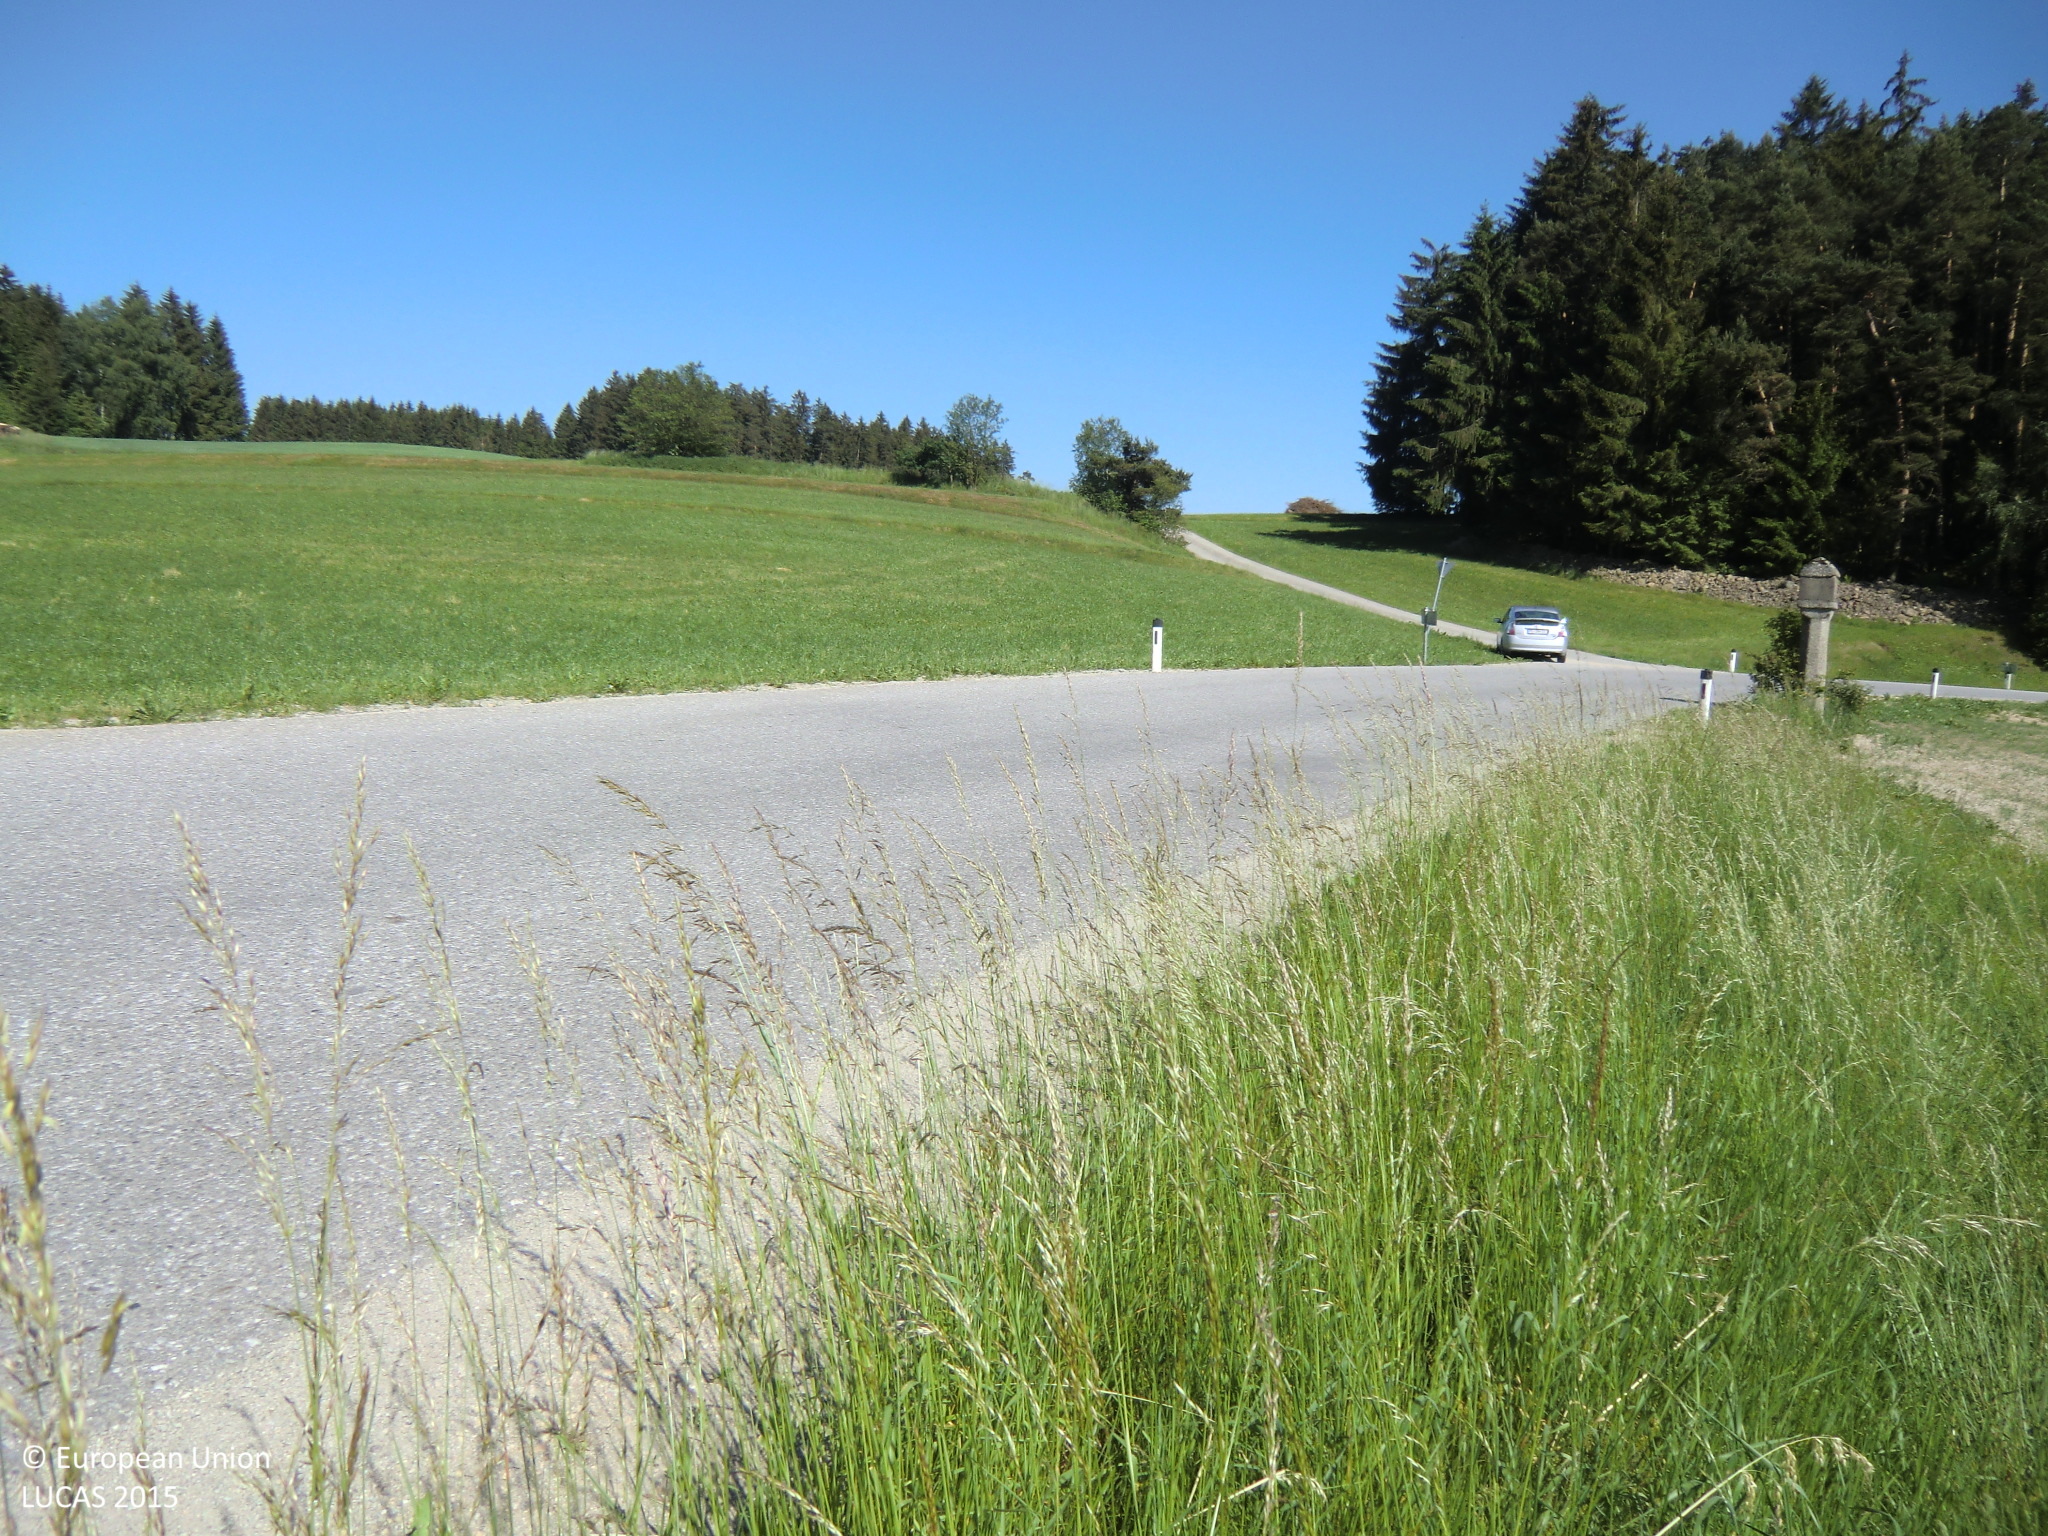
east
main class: Grassland
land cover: Grassland without tree/shrub cover
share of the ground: > 75 %
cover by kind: herbaceous plants 100 %
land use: Agriculture (excluding fallow land and kitchen gardens)
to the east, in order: Ditches and canals; Grassland without tree/shrub cover; Paved roads, cycling and walking lanes; Grassland without tree/shrub cover; Single bushes/trees; Grassland without tree/shrub cover; Potatoes; Rye
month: June
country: AT
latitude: 48.6480
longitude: 15.0648
